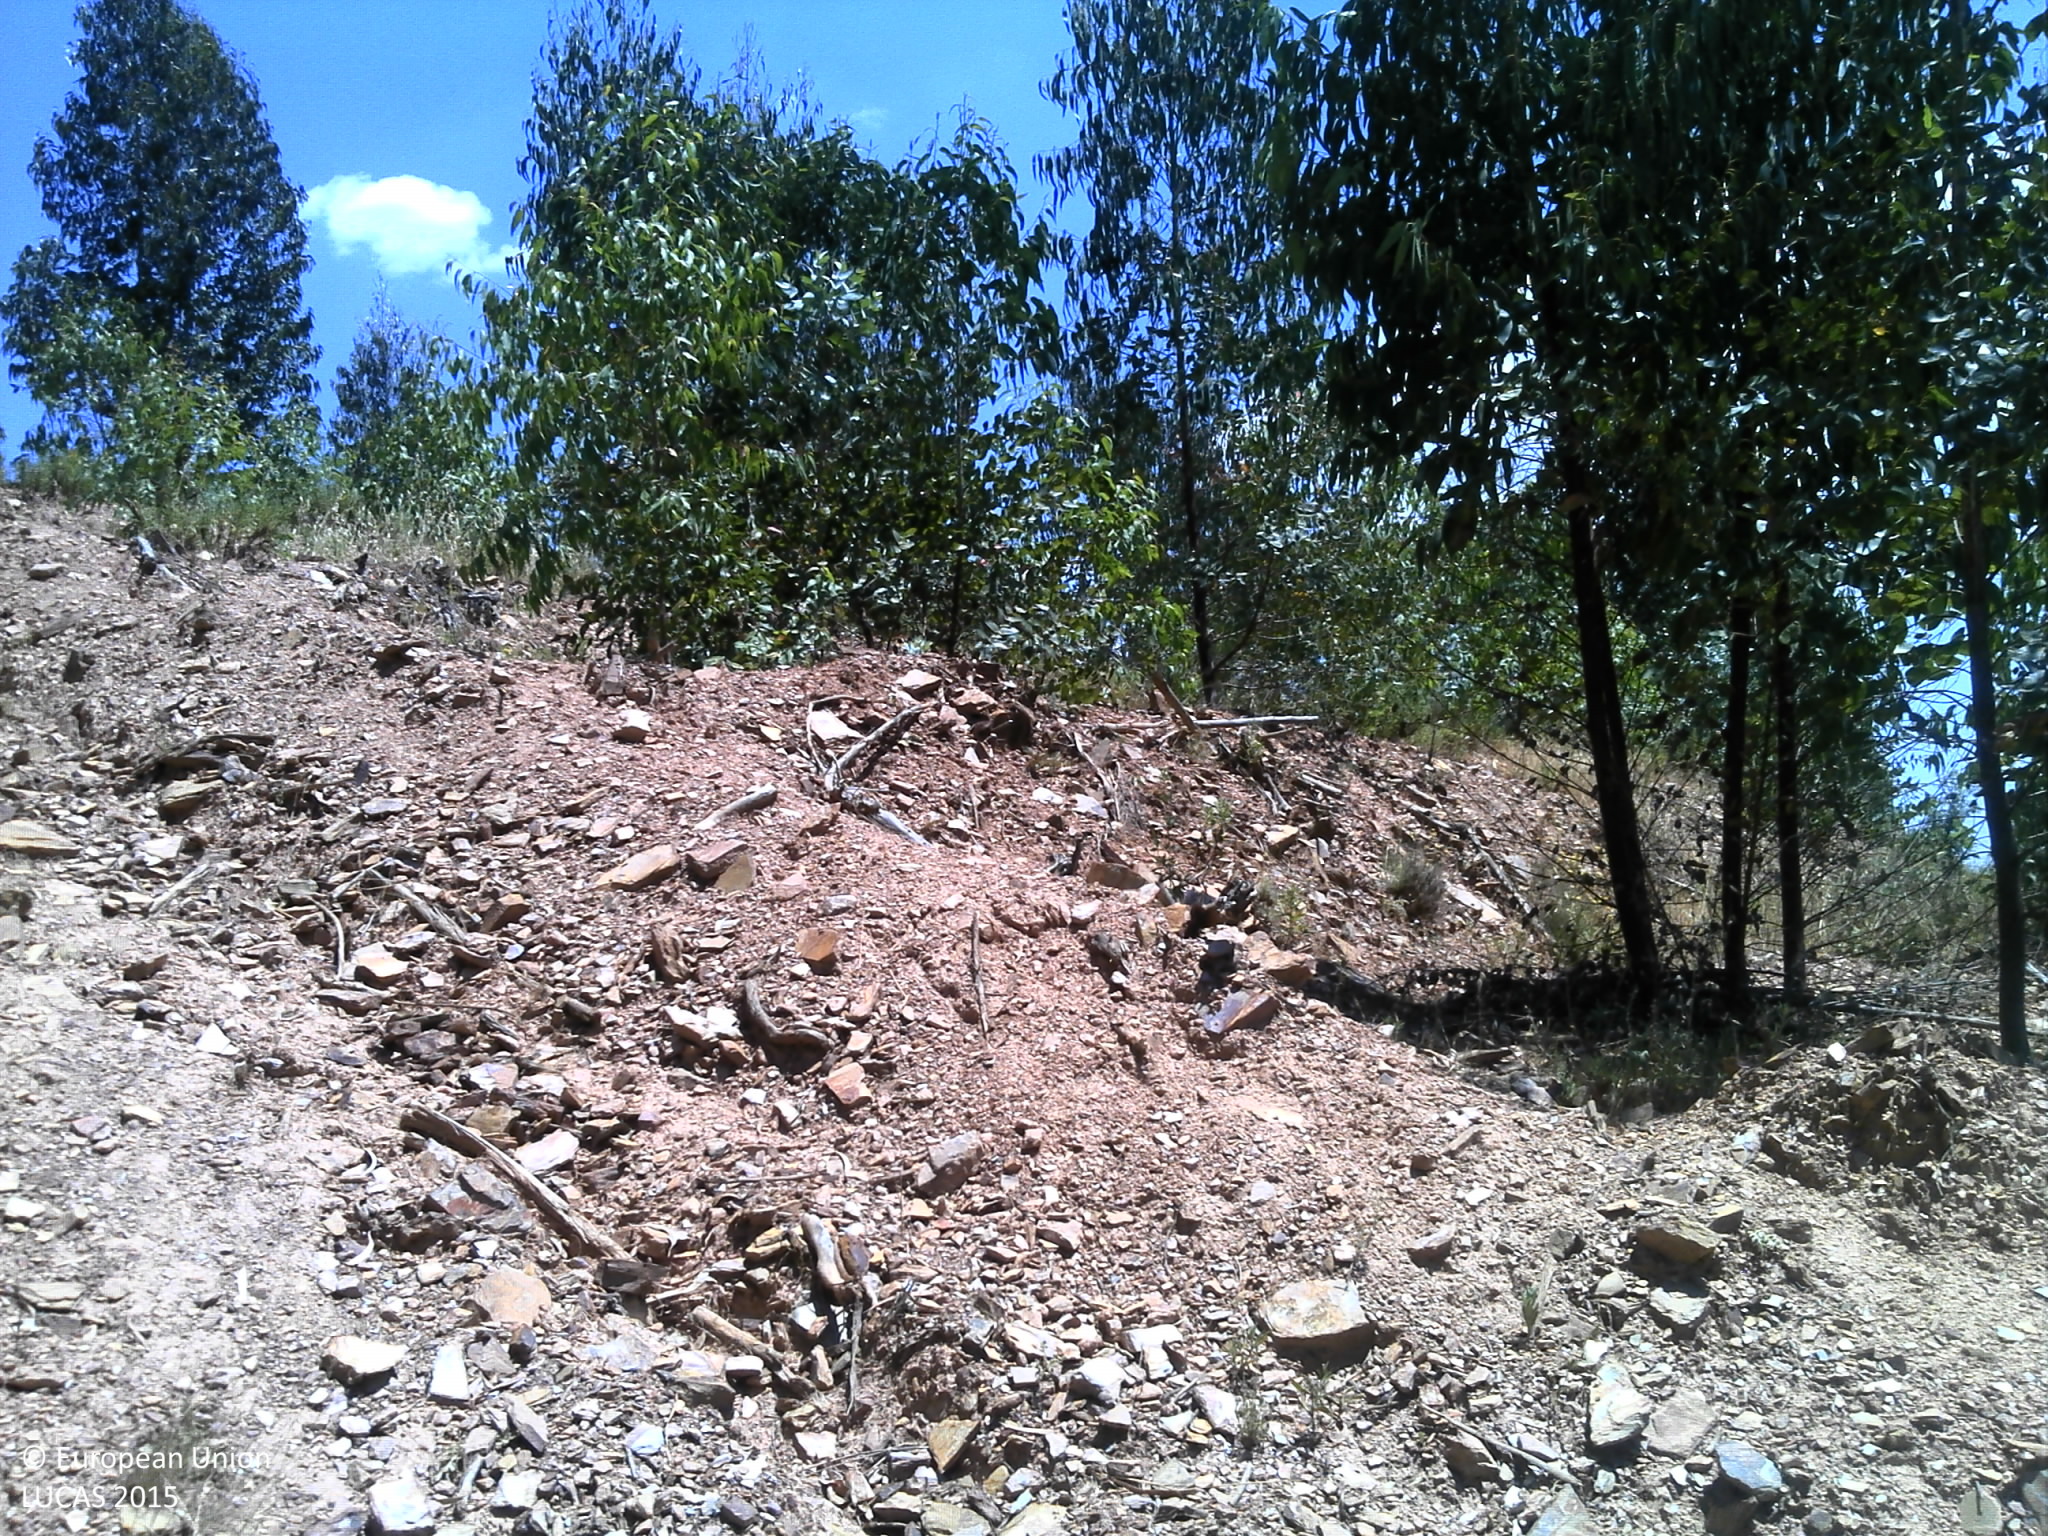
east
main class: Woodland
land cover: Broadleaved woodland
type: exotic forest
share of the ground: 25 - 50 %
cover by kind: broadleaved forest trees 50 %, unconsolidated bare surface 40 %, herbaceous plants 10 %
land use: Forestry
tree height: > 5 m
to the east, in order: Broadleaved woodland; Tracks; Broadleaved woodland; Tracks; Broadleaved woodland; Tracks; Broadleaved woodland; Shrubland without tree cover; Railways; Electric lines; Shrubland without tree cover
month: June
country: PT
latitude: 37.5122
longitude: -8.4844
